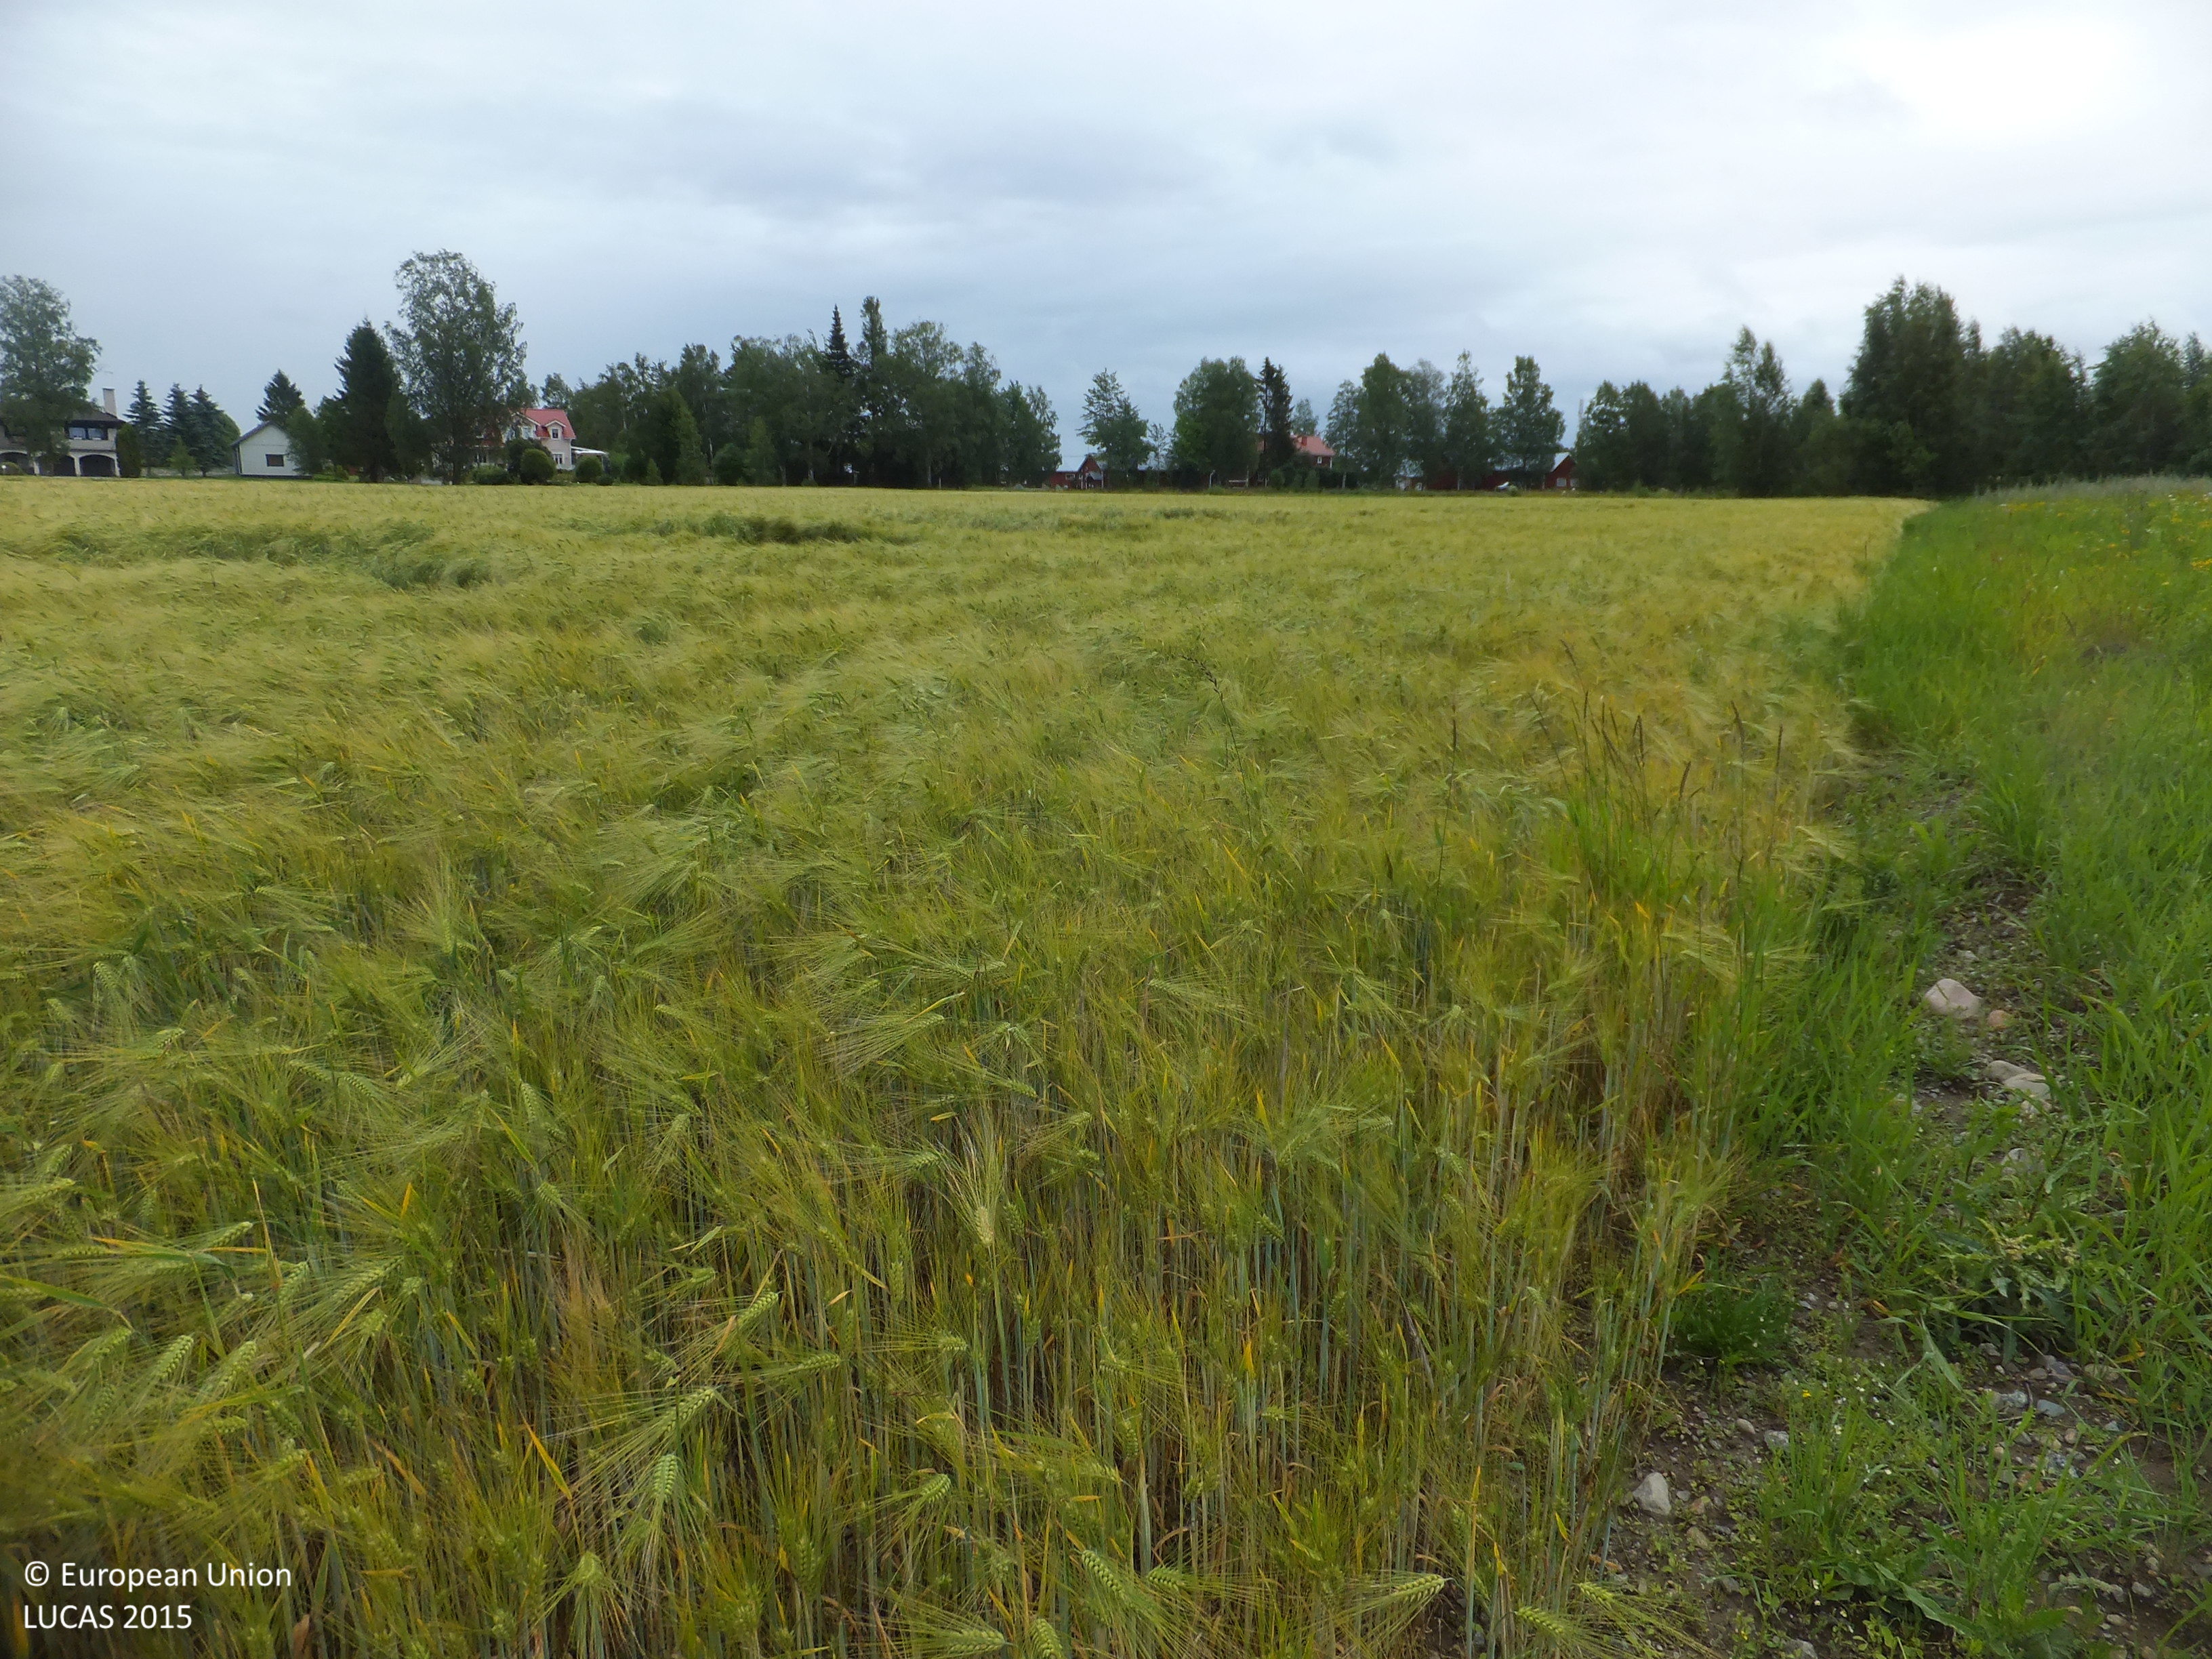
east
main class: Cropland
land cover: Barley
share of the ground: > 75 %
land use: Agriculture (excluding fallow land and kitchen gardens)
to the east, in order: Barley; Ditches and canals; Lines of trees; Paved roads, cycling and walking lanes; Grassland with sparse tree/shrub cover; Artificial constructions in urban areas; Fences; Other bare soil; Grassland without tree/shrub cover; Fences; Ditches and canals; Grass margins; Paved roads, cycling and walking lanes
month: July
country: FI
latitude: 63.0238
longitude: 21.7997
